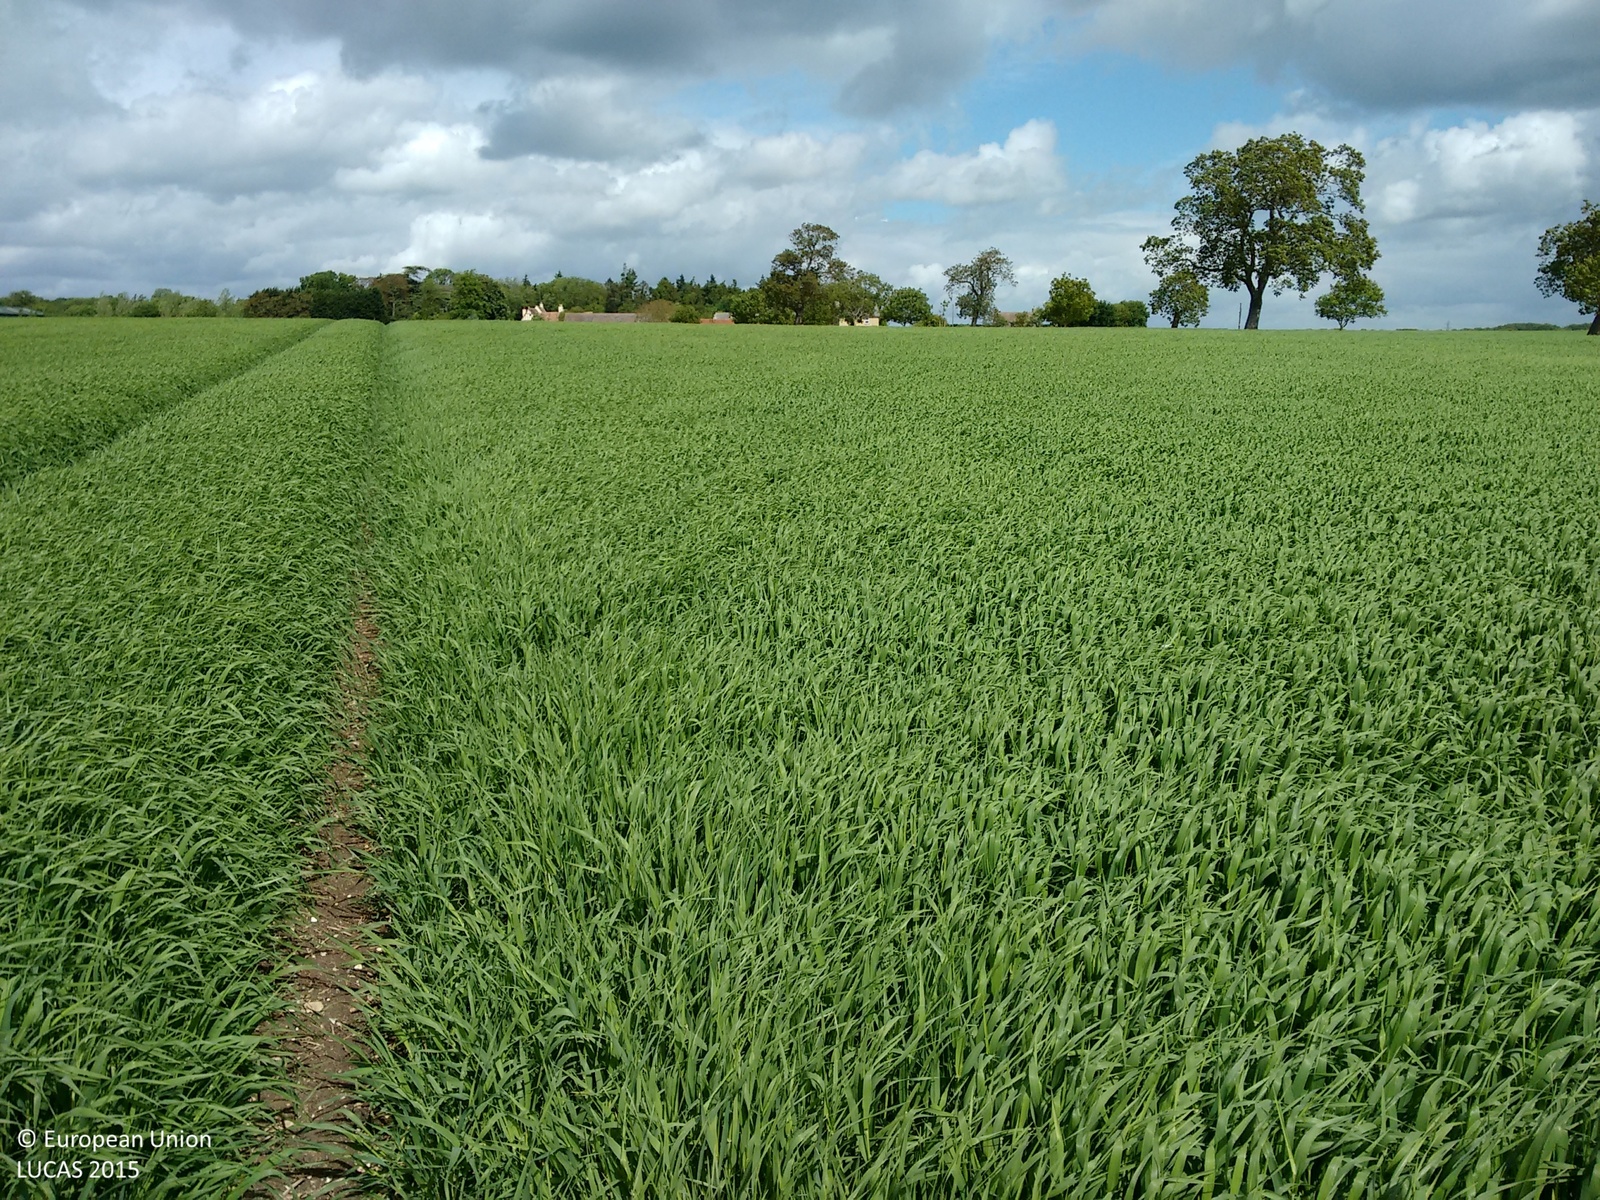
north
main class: Cropland
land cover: Barley
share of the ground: > 75 %
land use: Agriculture (excluding fallow land and kitchen gardens)
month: June
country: GB
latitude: 52.2338
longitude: -0.3298
